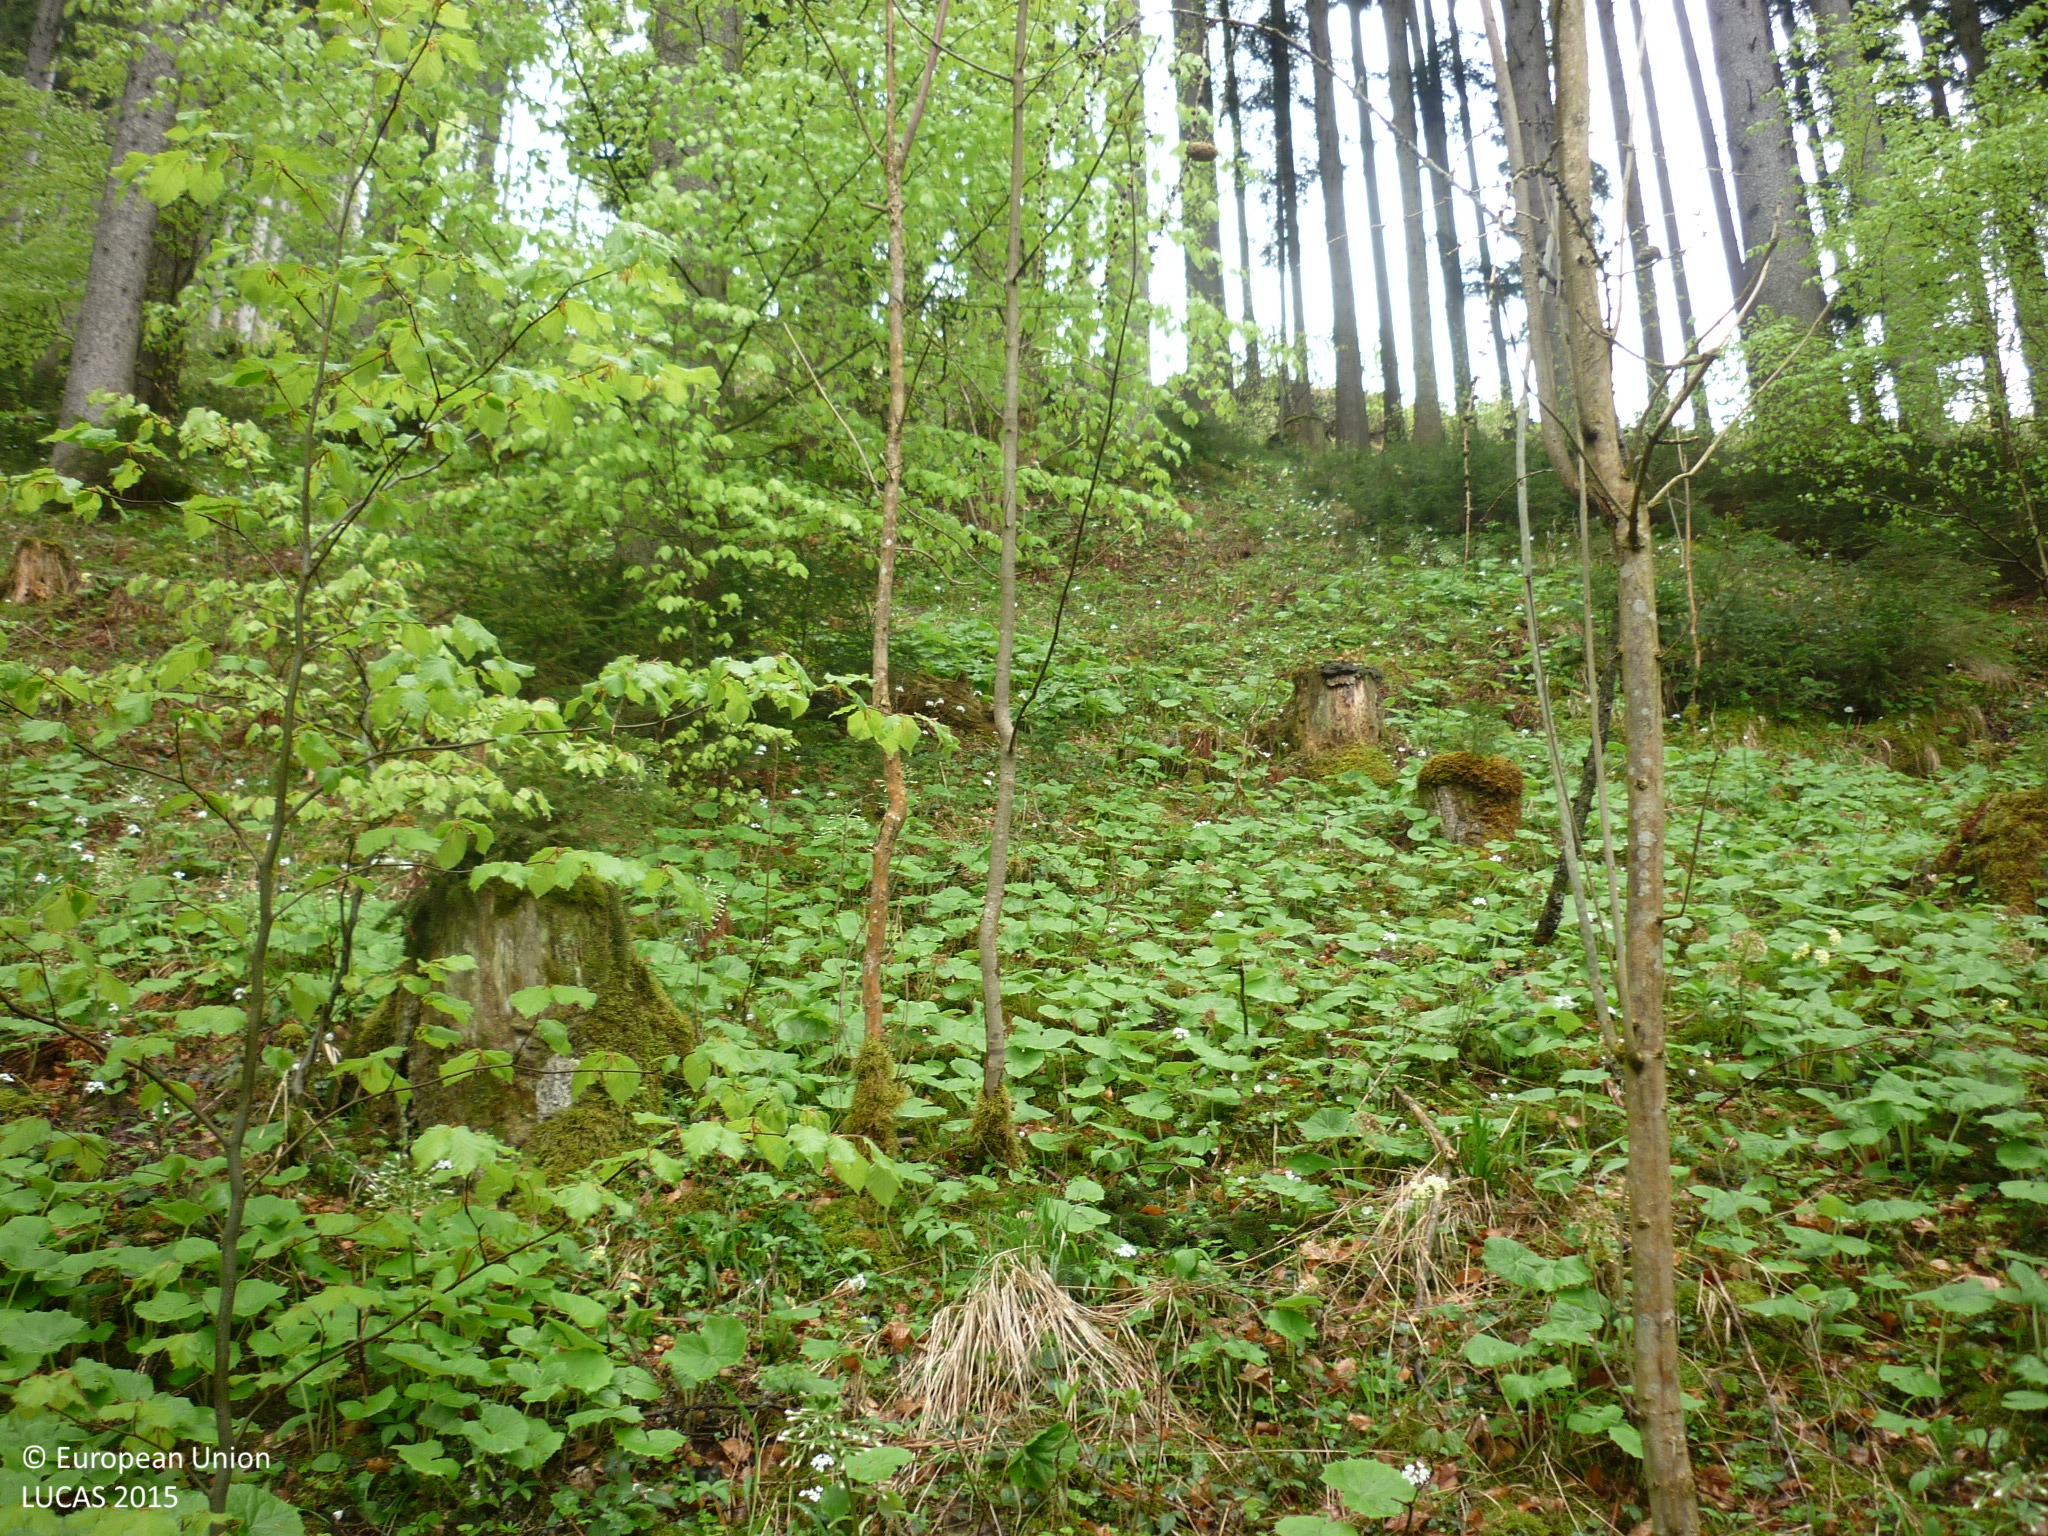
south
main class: Woodland
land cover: Spruce dominated mixed woodland
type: alpine coniferous forest
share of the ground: > 75 %
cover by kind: coniferous forest trees 60 %, broadleaved forest trees 30 %, herbaceous plants 5 %, lichens and mosses 5 %
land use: Forestry
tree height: > 5 m
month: May
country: AT
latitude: 47.7276
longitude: 14.6796
